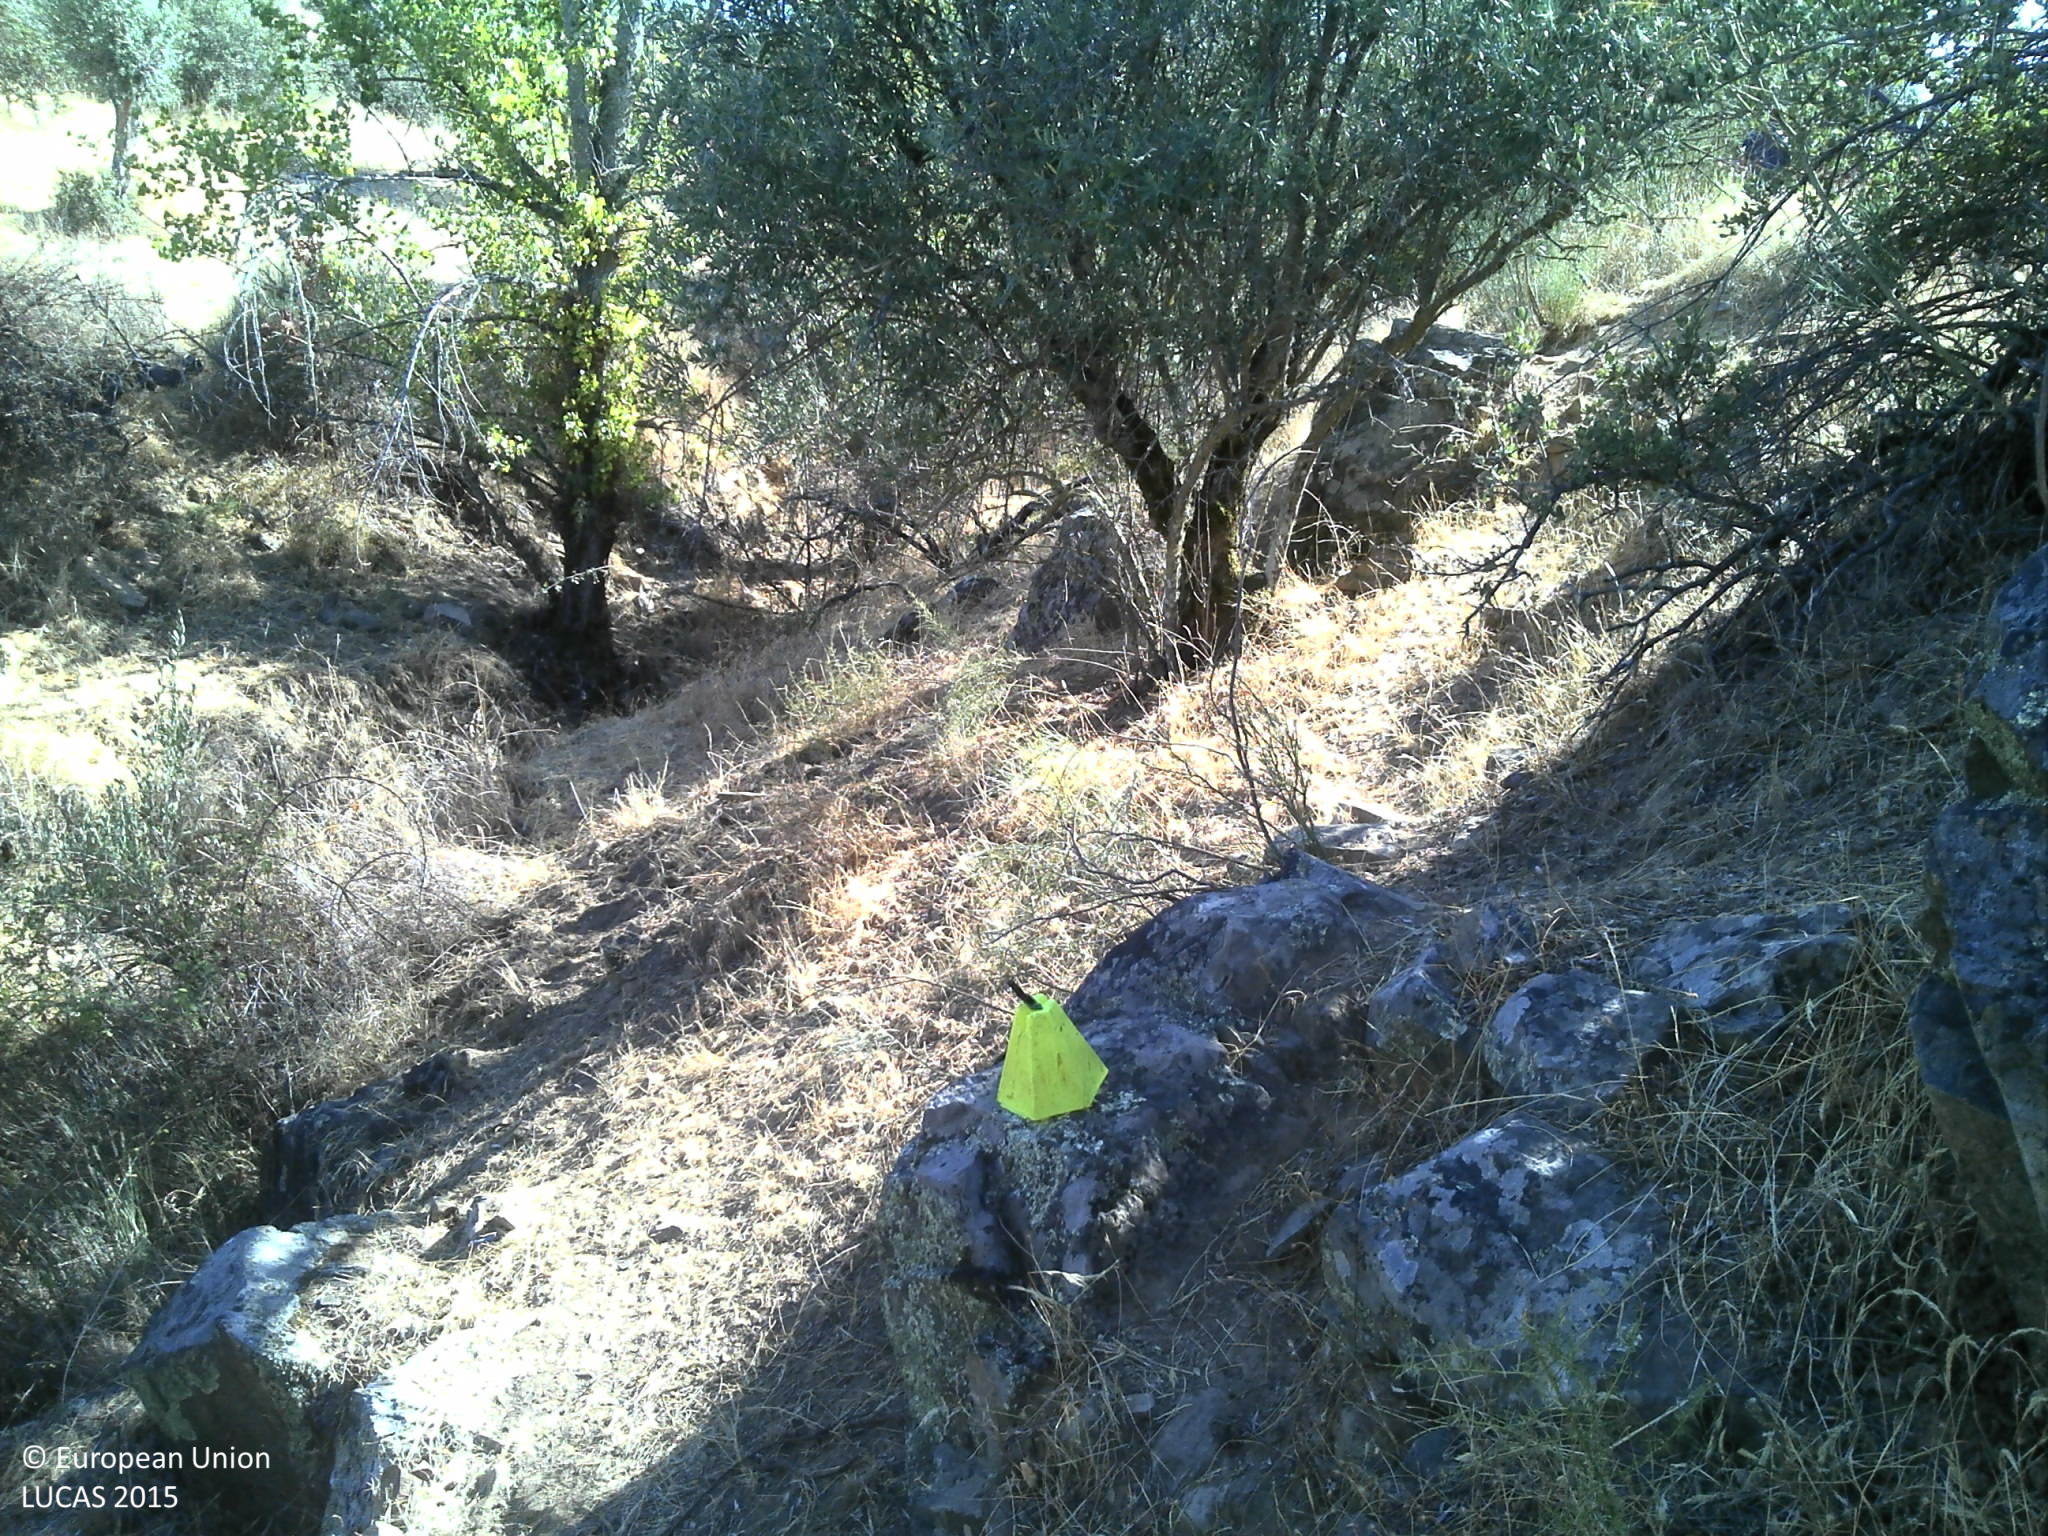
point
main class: Cropland
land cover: Olive groves
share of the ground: 25 - 50 %
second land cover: Grassland without tree/shrub cover
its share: 25 - 50 %
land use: Agriculture (excluding fallow land and kitchen gardens)
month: July
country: PT
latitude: 39.0419
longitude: -7.5431
